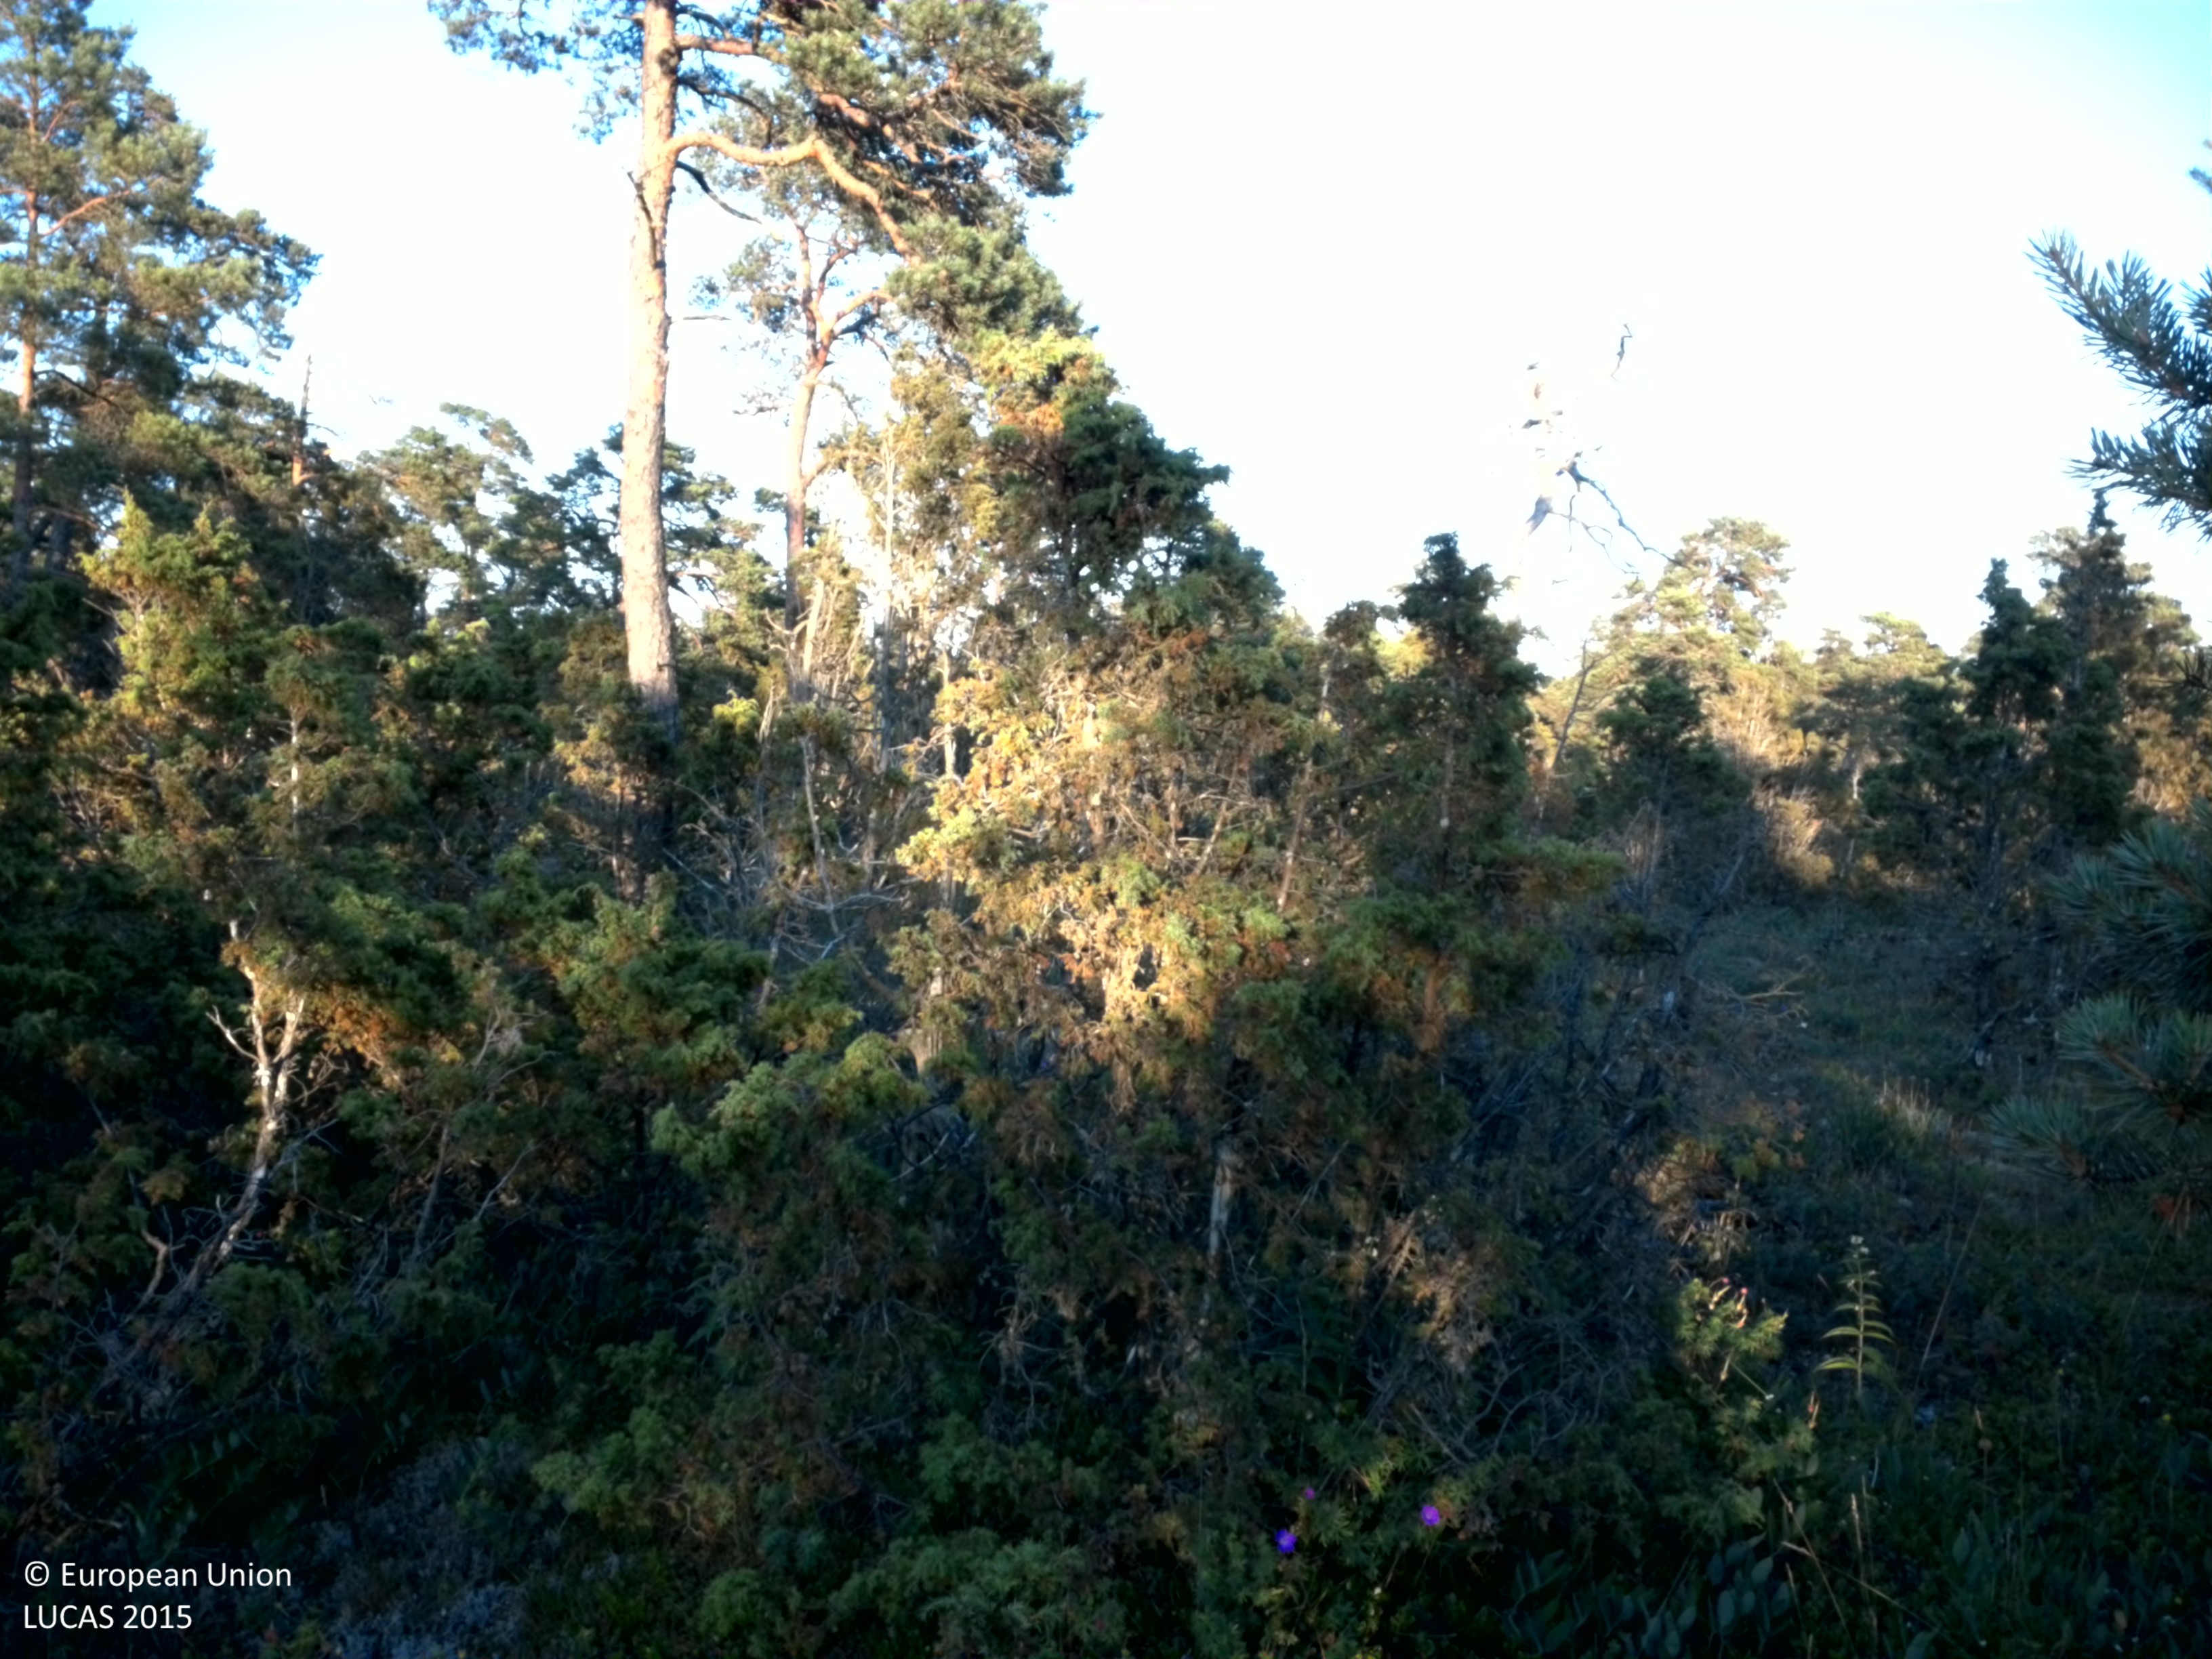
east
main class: Shrubland
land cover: Shrubland with sparse tree cover
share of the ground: > 75 %
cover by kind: shrubs 75 %, herbaceous plants 15 %, coniferous forest trees 5 %, lichens and mosses 5 %
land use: Semi-natural and natural areas not in use
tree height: > 5 m
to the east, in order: Shrubland with sparse tree cover; Pine dominated coniferous woodland
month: July
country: SE
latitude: 57.3975
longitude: 18.6465
